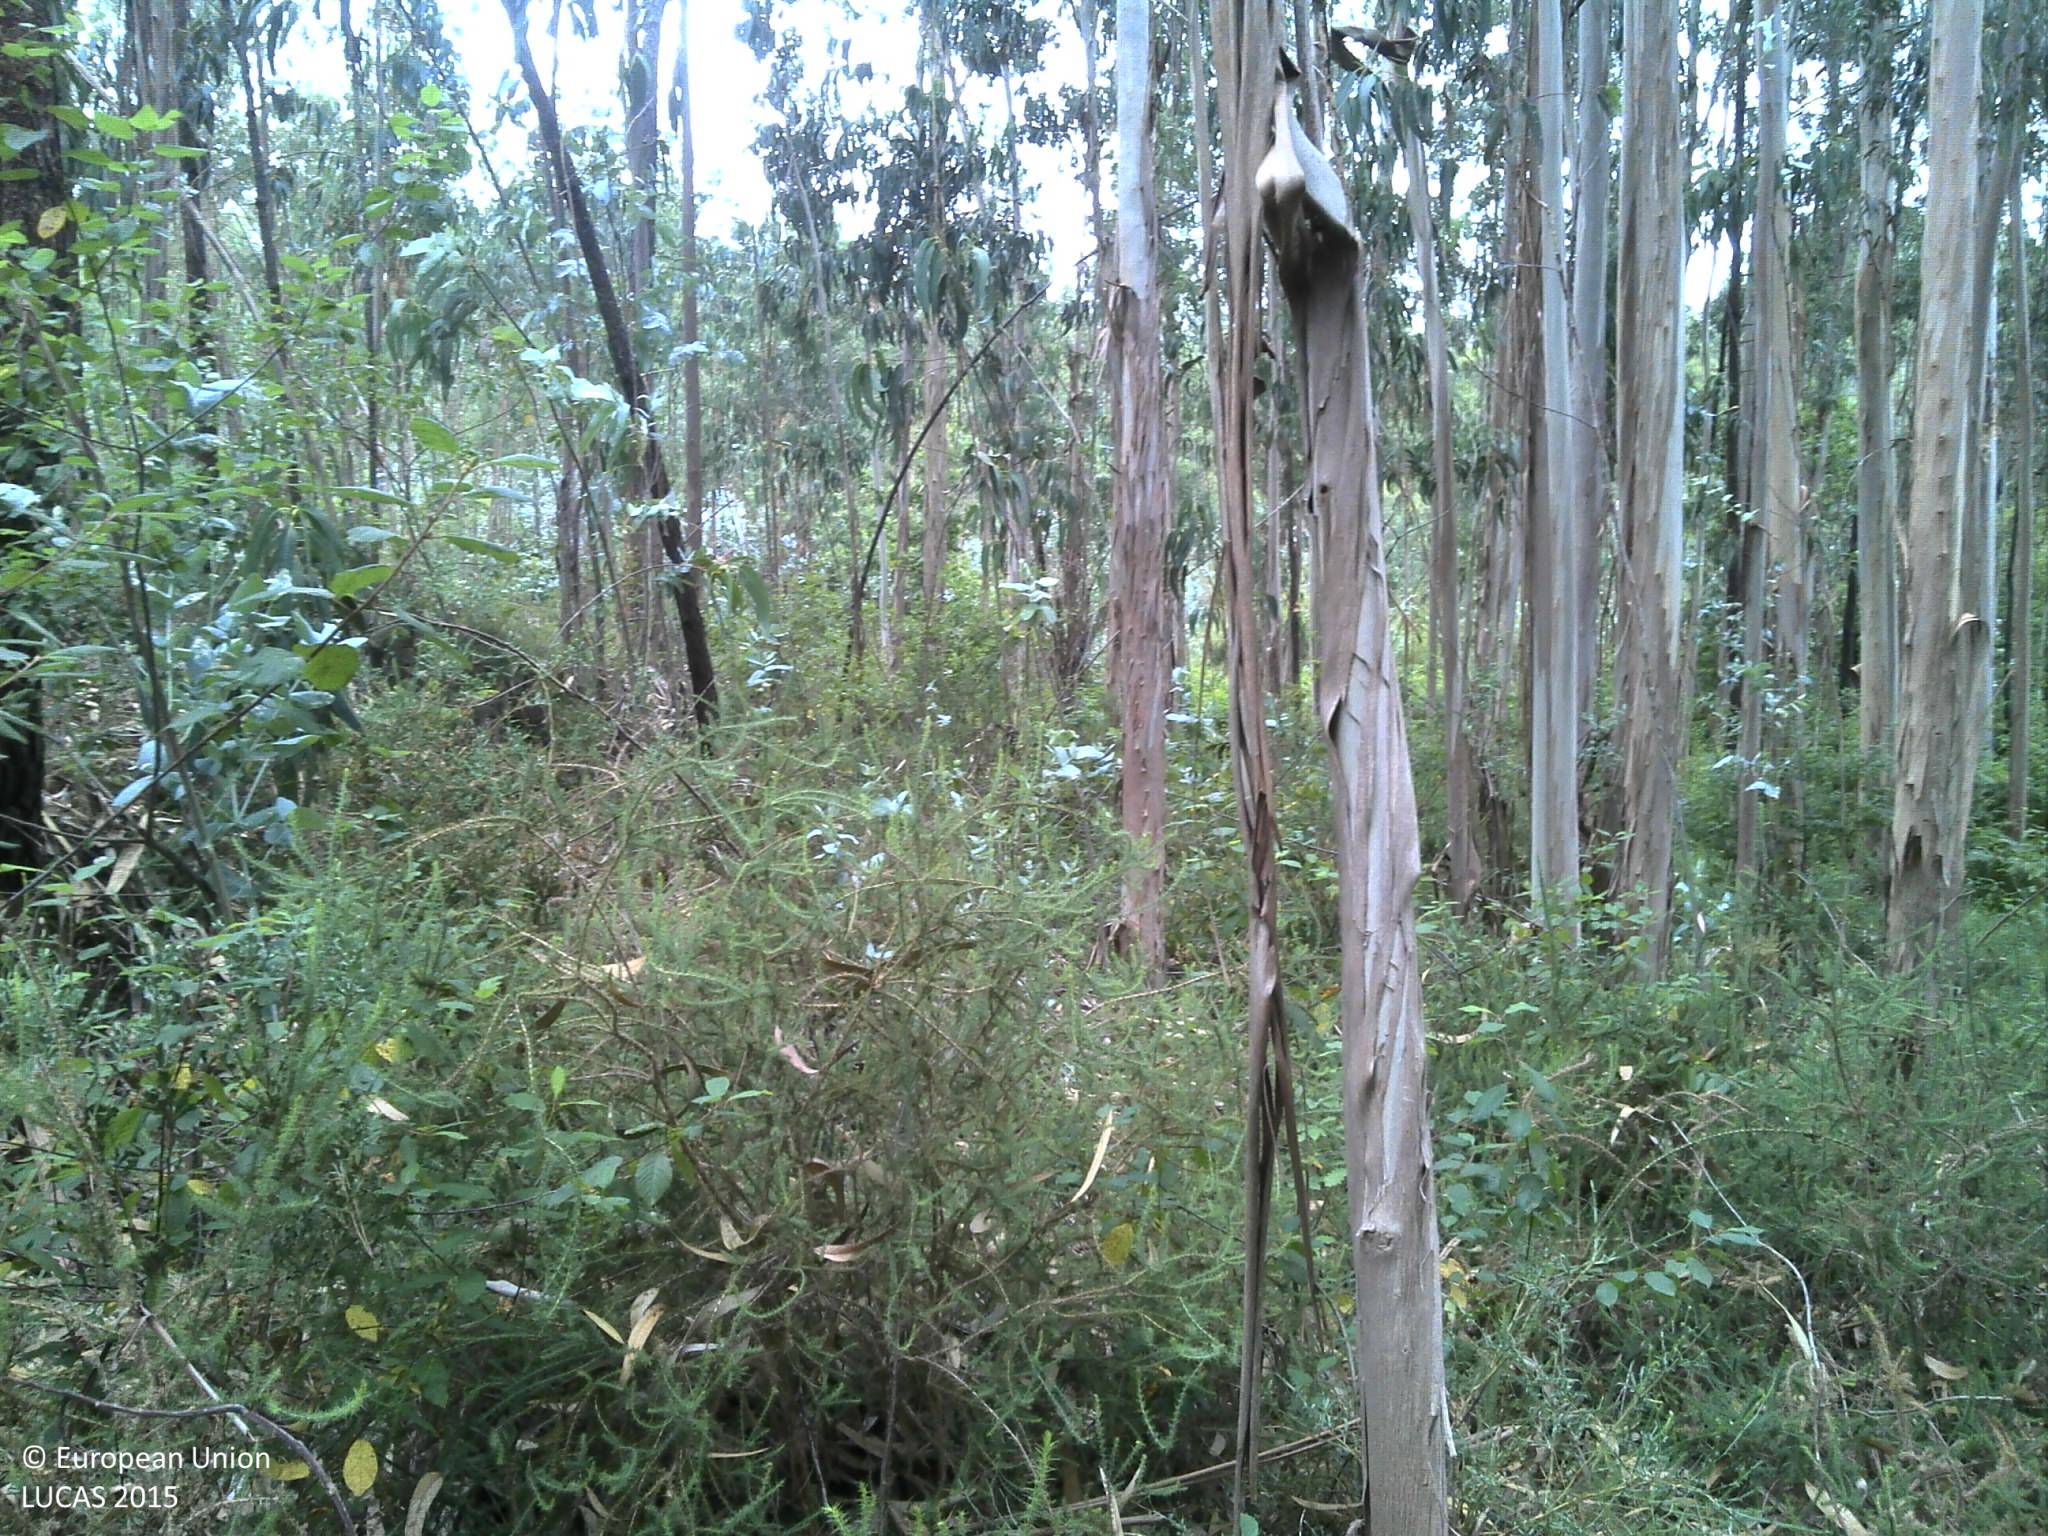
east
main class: Woodland
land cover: Broadleaved woodland
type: boreal forest
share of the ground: 50 - 75 %
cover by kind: broadleaved forest trees 60 %, shrubs 25 %, unconsolidated bare surface 10 %, herbaceous plants 5 %
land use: Forestry
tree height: > 5 m
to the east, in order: Broadleaved woodland; Tracks; Broadleaved woodland; Ditches and canals; Broadleaved woodland
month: June
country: PT
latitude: 40.7670
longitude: -8.4933
